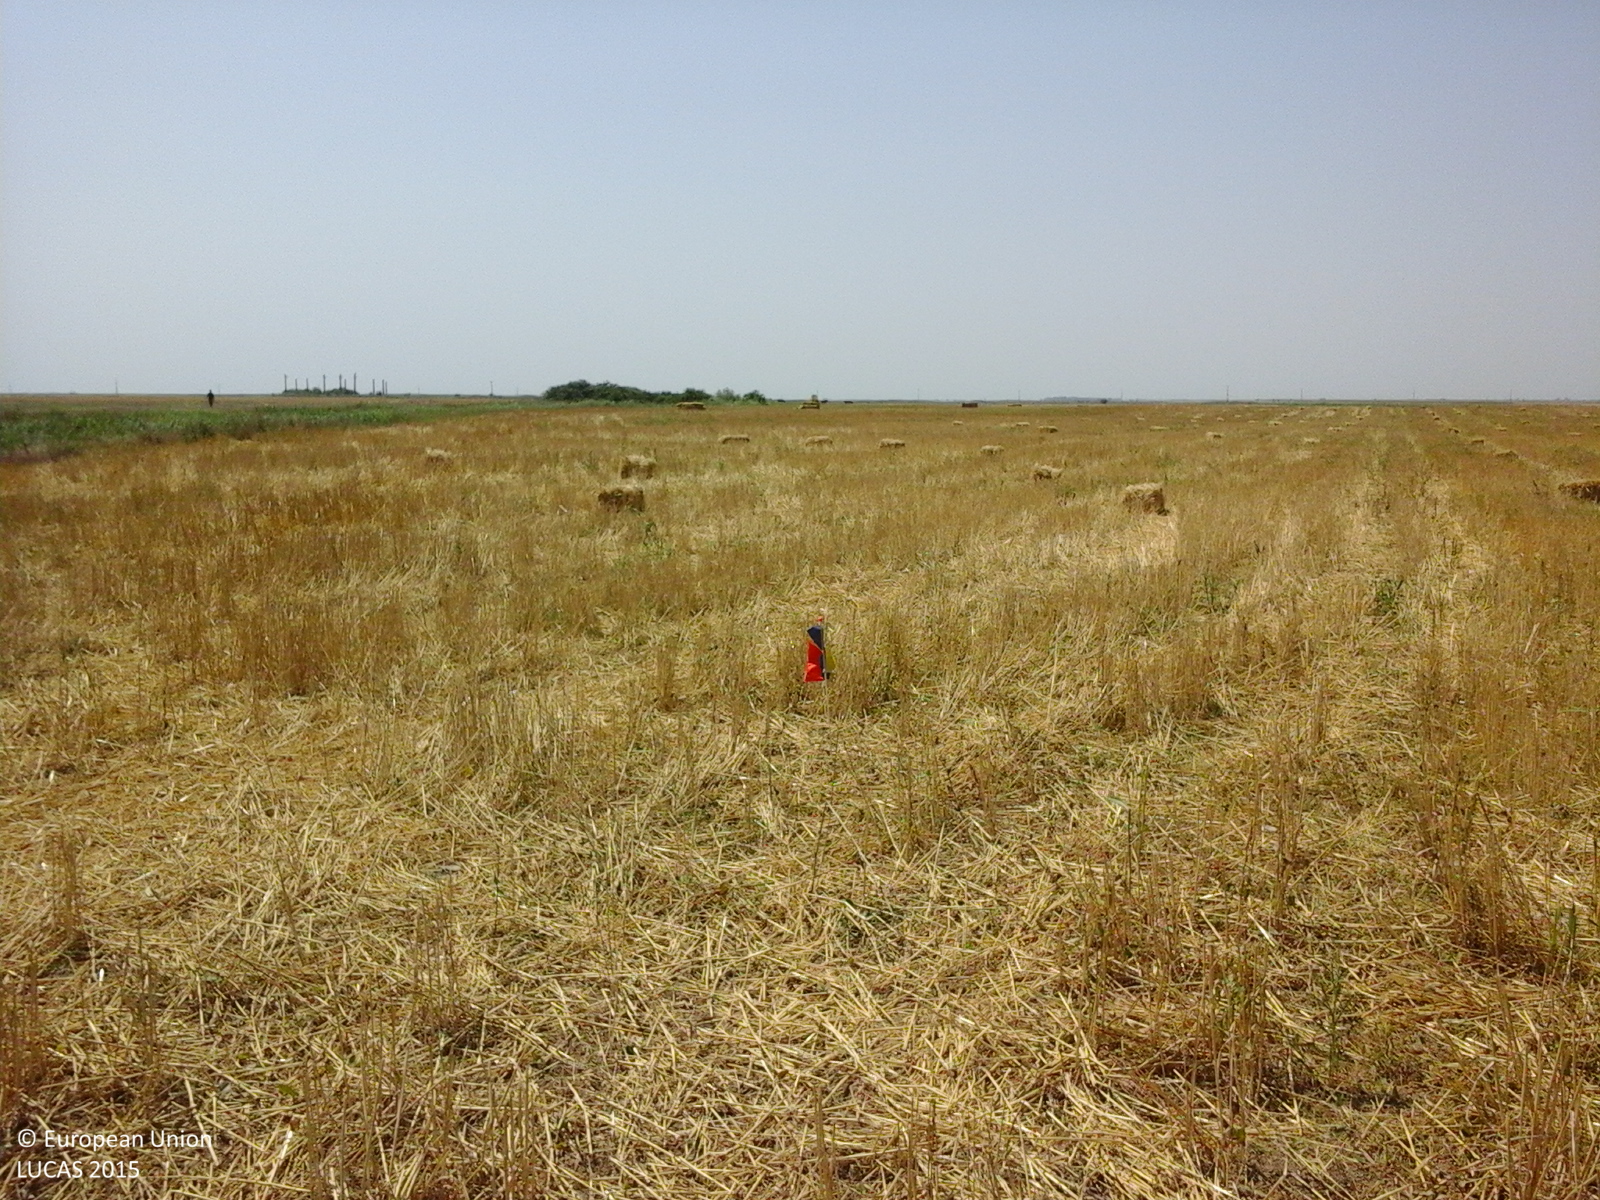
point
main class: Cropland
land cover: Common wheat
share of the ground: < 10 %
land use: Agriculture (excluding fallow land and kitchen gardens)
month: August
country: RO
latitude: 45.5337
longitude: 27.6372
